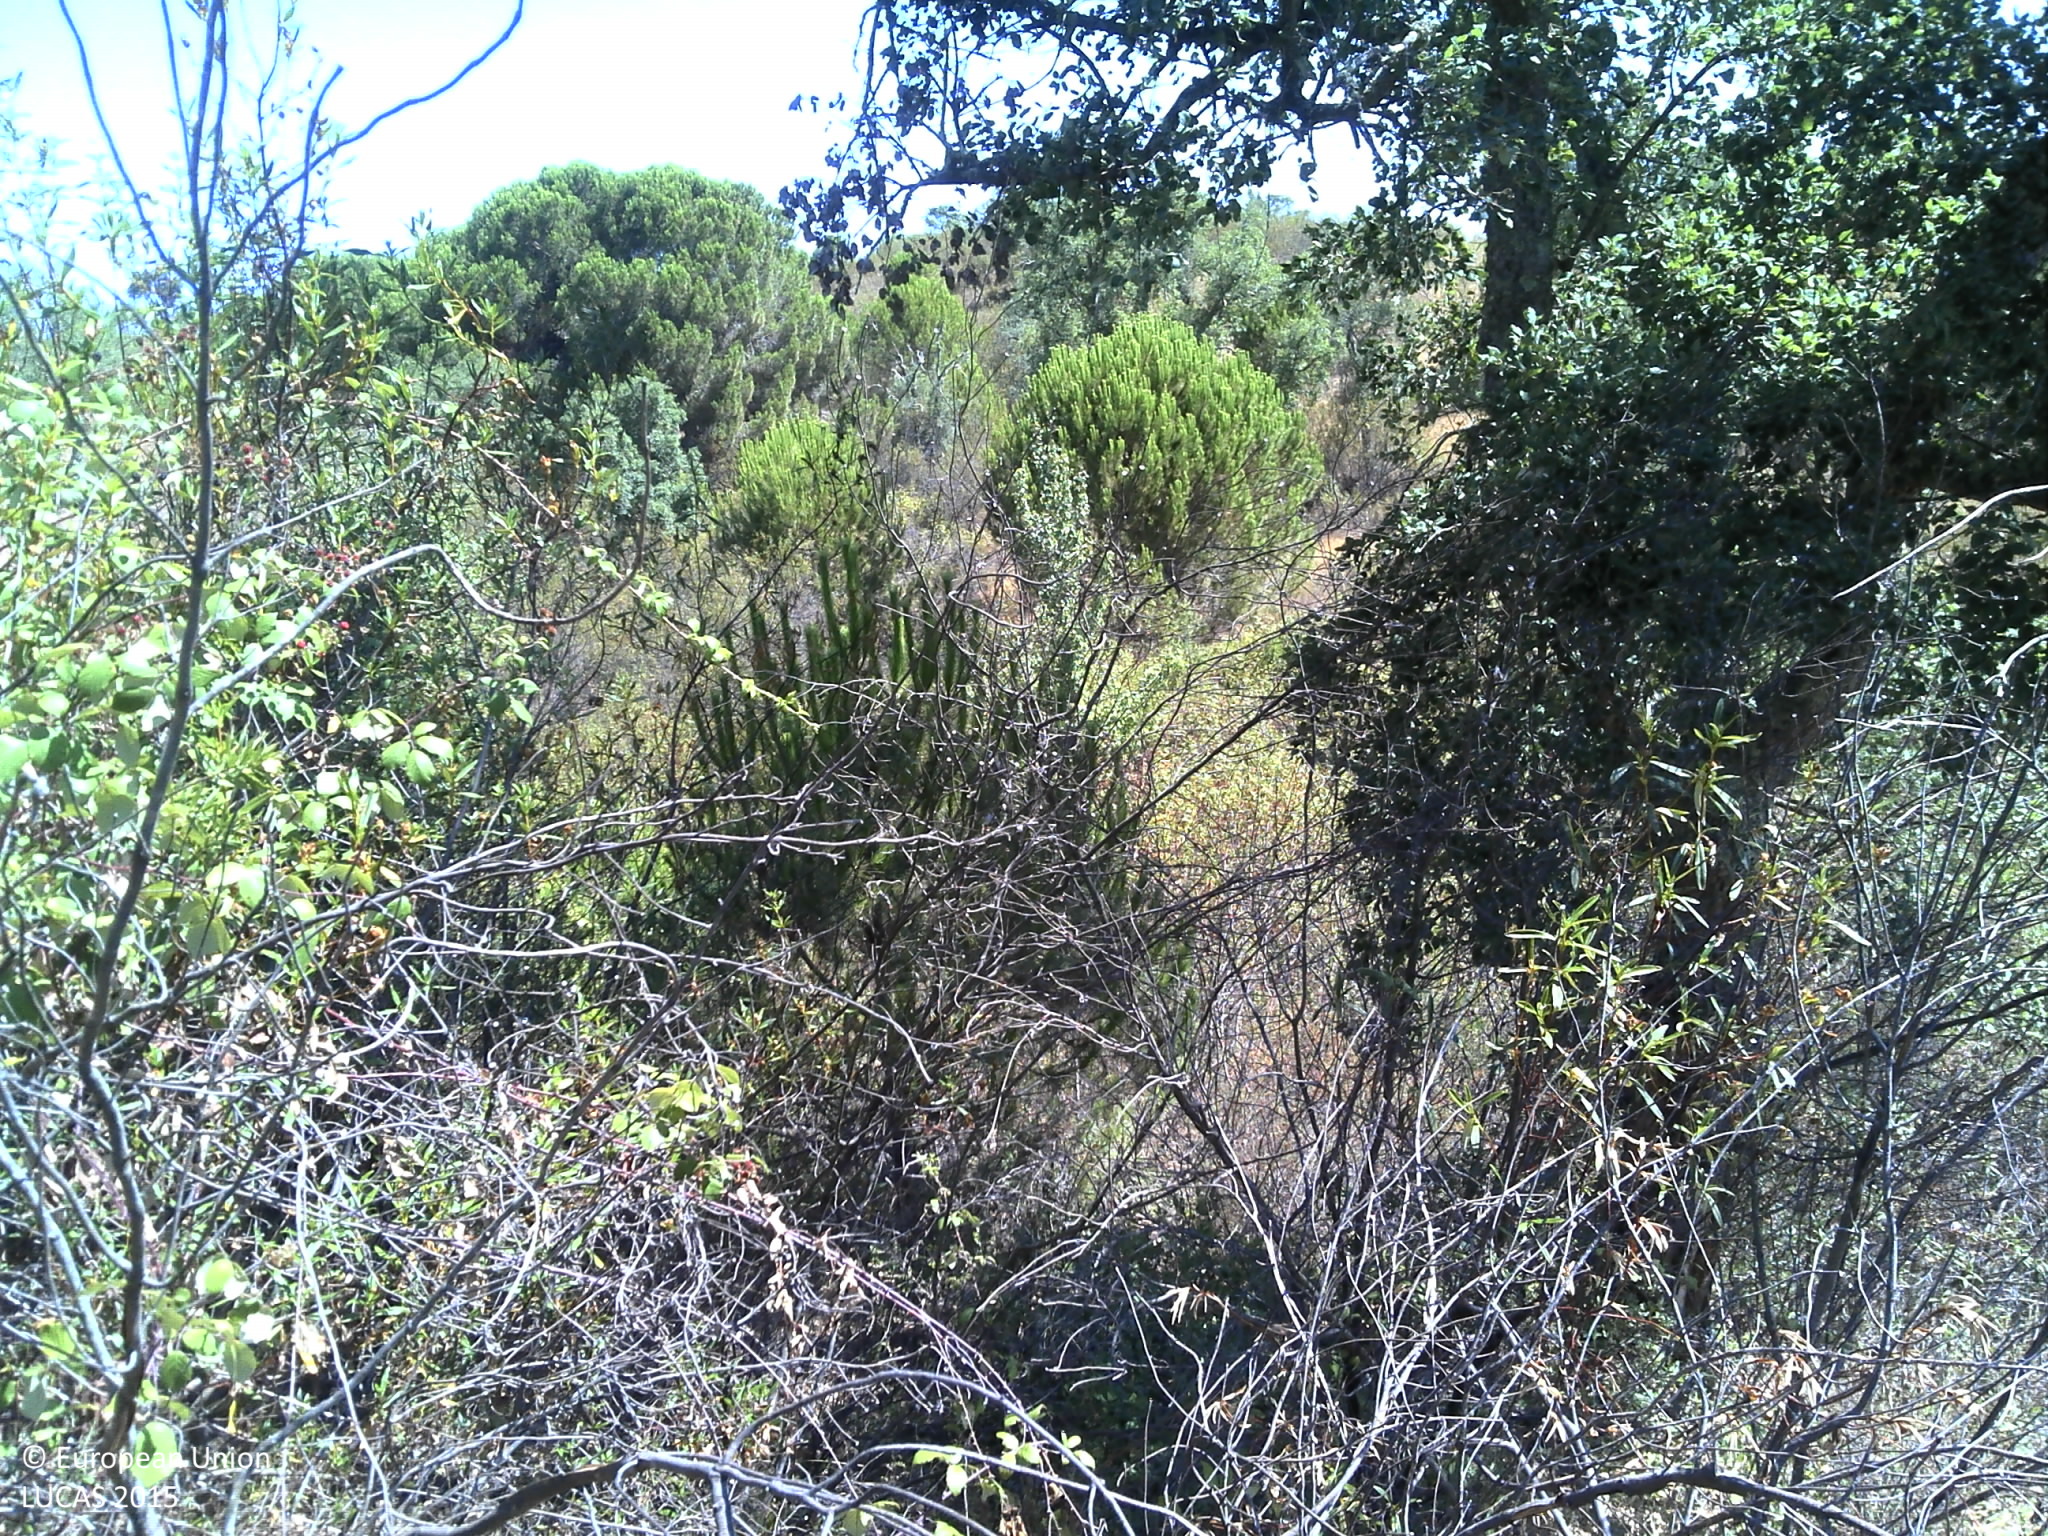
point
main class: Woodland
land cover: Pine dominated mixed woodland
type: coniferous forest of the mediterranean region
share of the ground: 10 - 25 %
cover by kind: shrubs 45 %, coniferous forest trees 25 %, unconsolidated bare surface 20 %, broadleaved forest trees 10 %
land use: Forestry
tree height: > 5 m
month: July
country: PT
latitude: 38.4862
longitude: -8.5222
